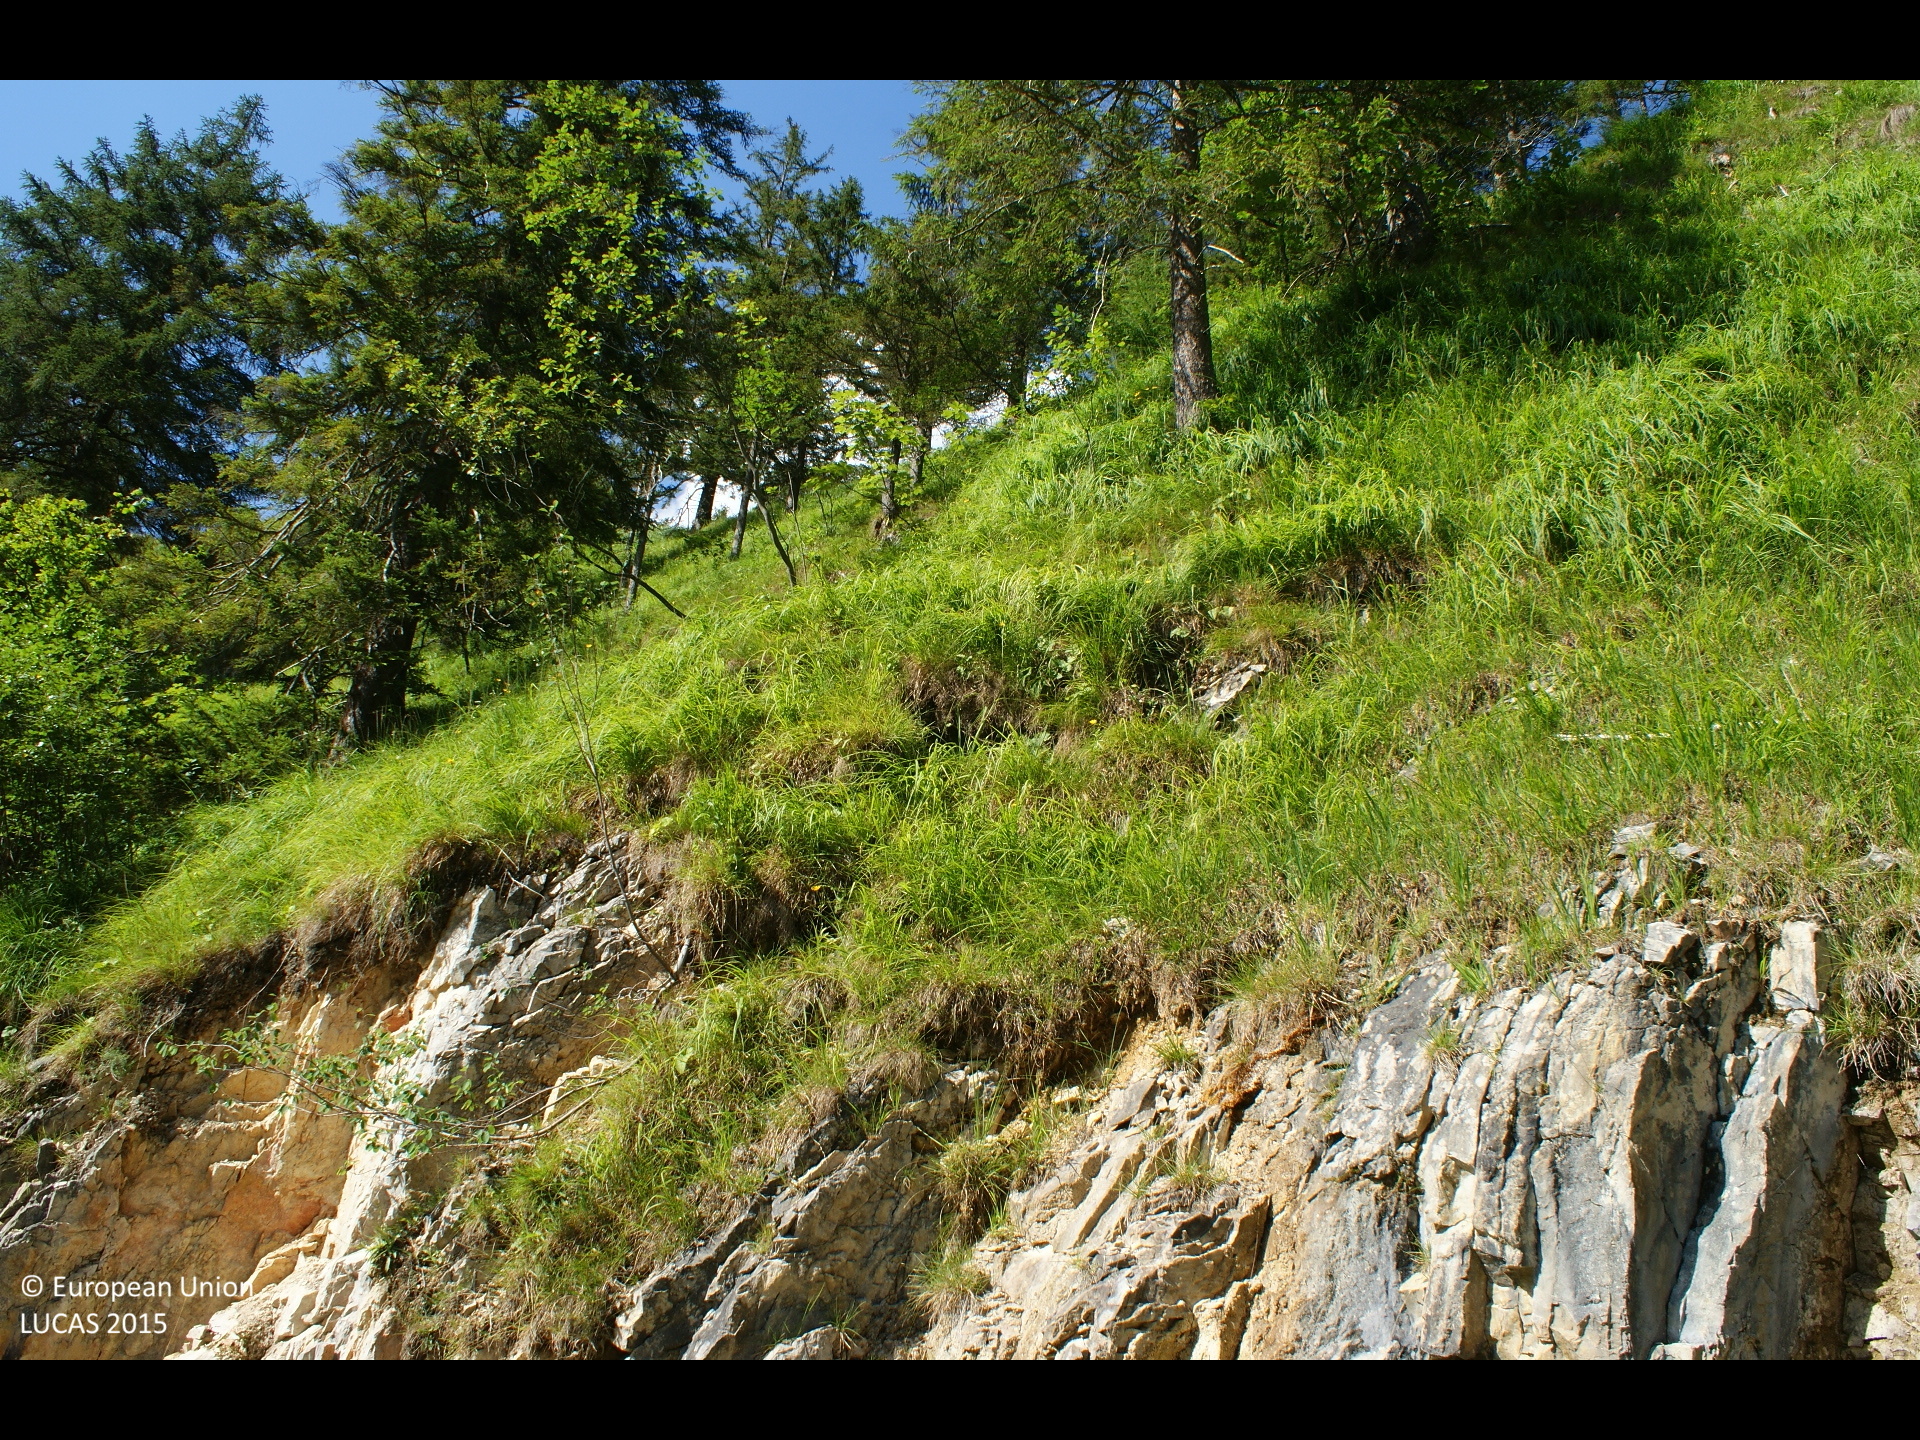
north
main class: Woodland
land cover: Spruce dominated mixed woodland
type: mesophytic deciduous forest
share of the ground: 50 - 75 %
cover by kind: coniferous forest trees 35 %, herbaceous plants 35 %, broadleaved forest trees 20 %, shrubs 5 %
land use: Forestry
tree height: > 5 m
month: July
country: AT
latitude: 47.7589
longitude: 14.7894
